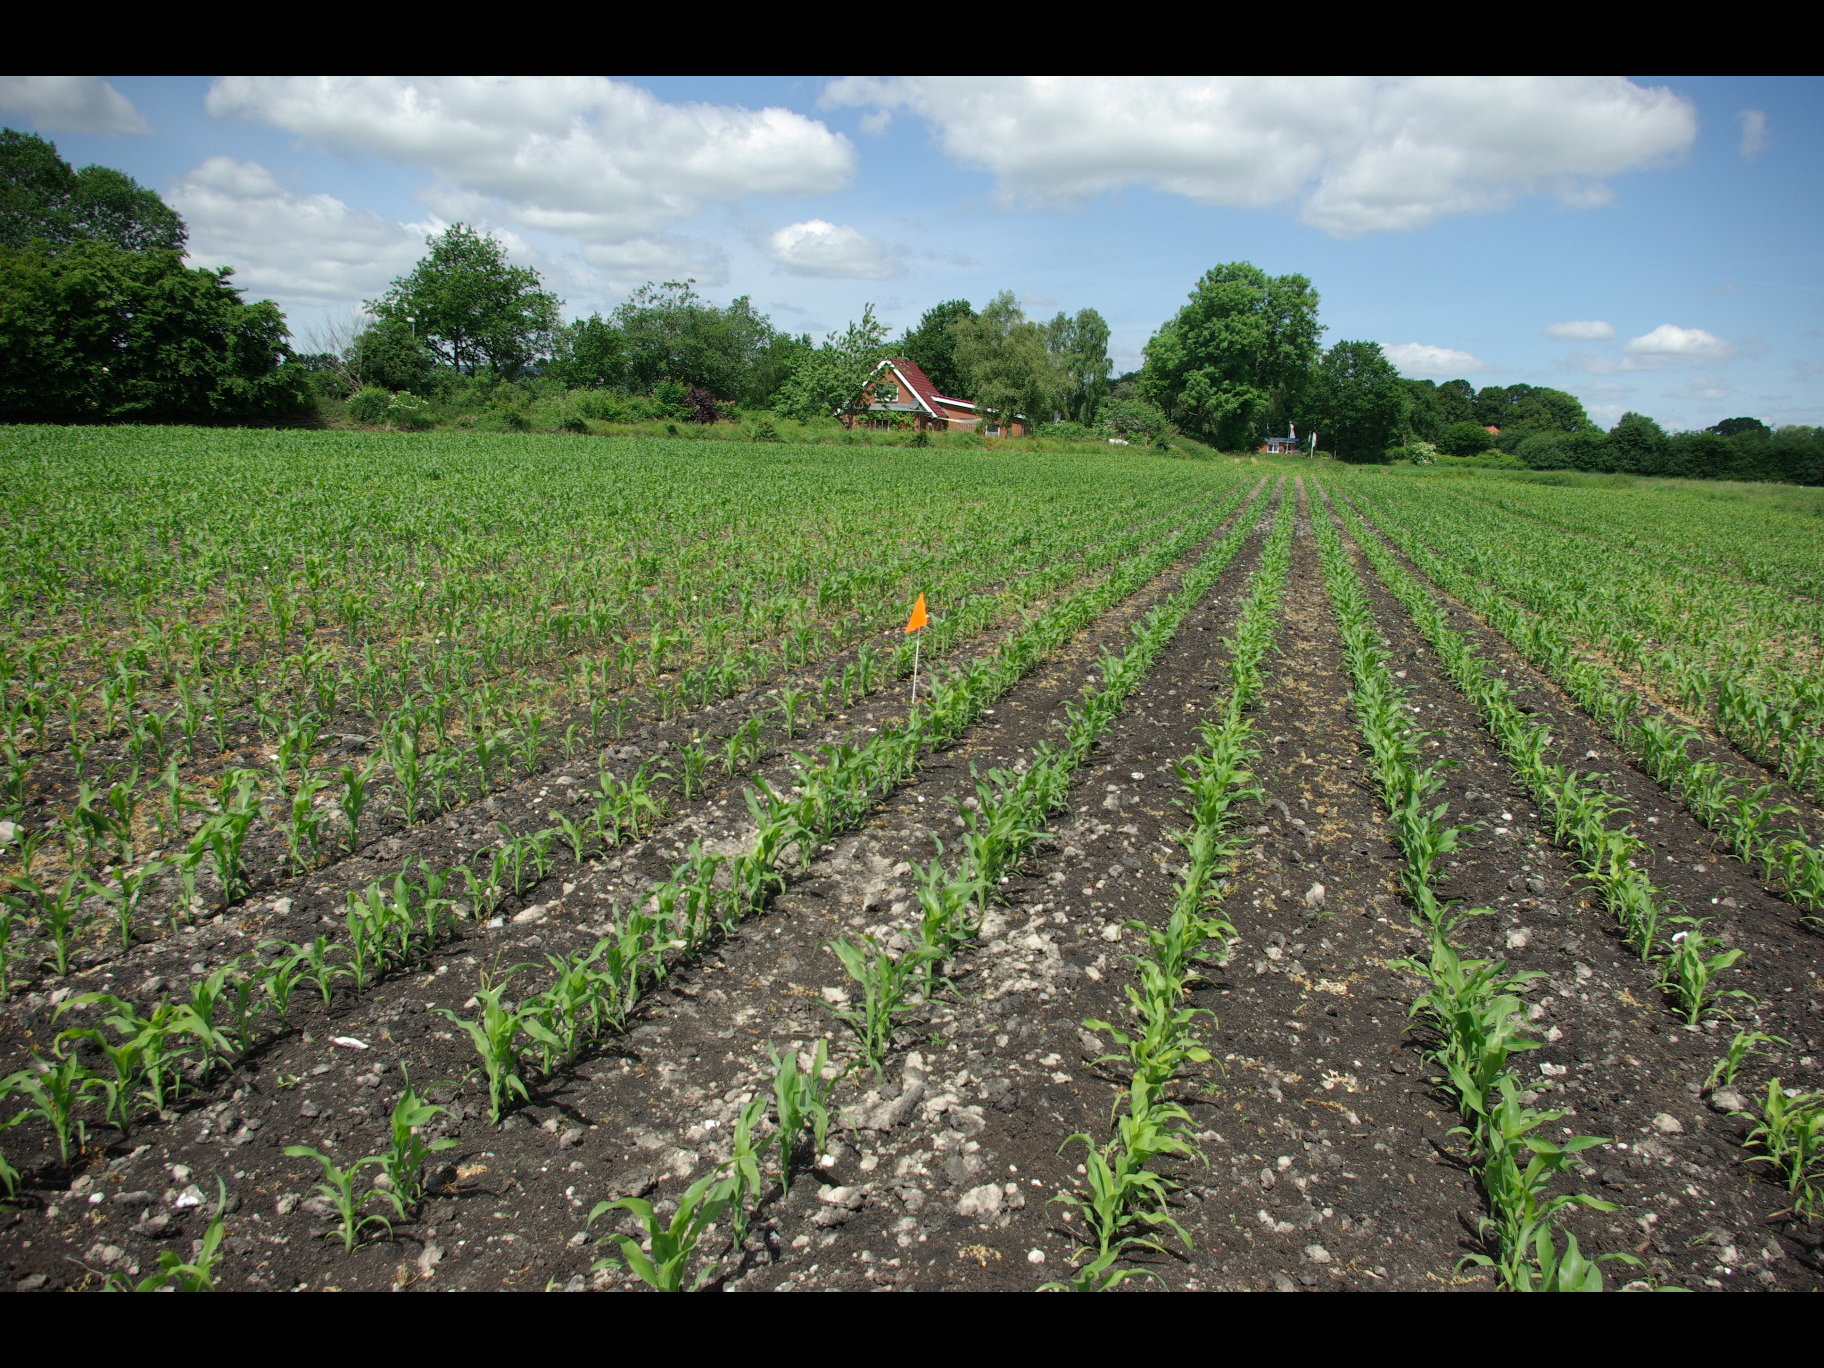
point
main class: Cropland
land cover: Maize
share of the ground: 25 - 50 %
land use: Agriculture (excluding fallow land and kitchen gardens)
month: June
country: DE
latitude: 54.3539
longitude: 9.6463
